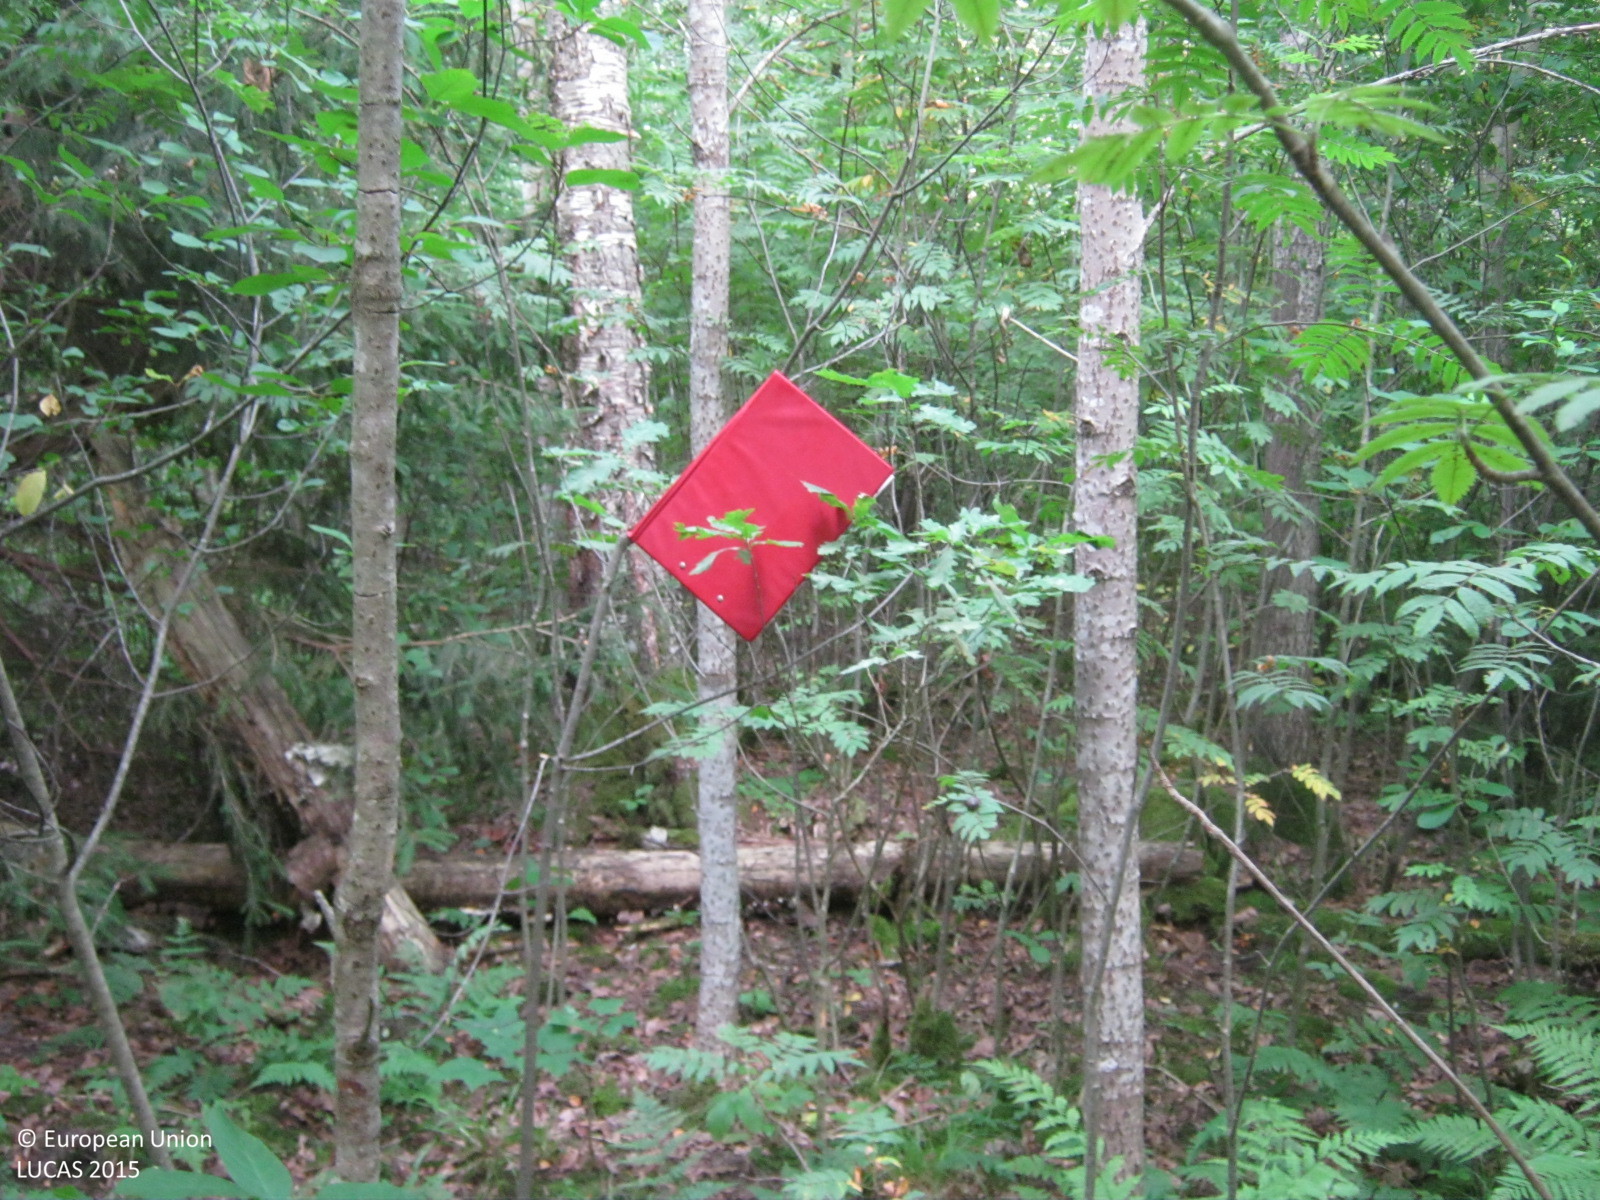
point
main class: Woodland
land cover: Broadleaved woodland
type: non-riverine alder, birch or aspen forest
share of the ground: > 75 %
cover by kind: broadleaved forest trees 80 %, coniferous forest trees 10 %, herbaceous plants 5 %, unconsolidated bare surface 5 %
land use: Forestry
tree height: > 5 m
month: August
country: LV
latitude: 57.3916
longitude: 24.6533
